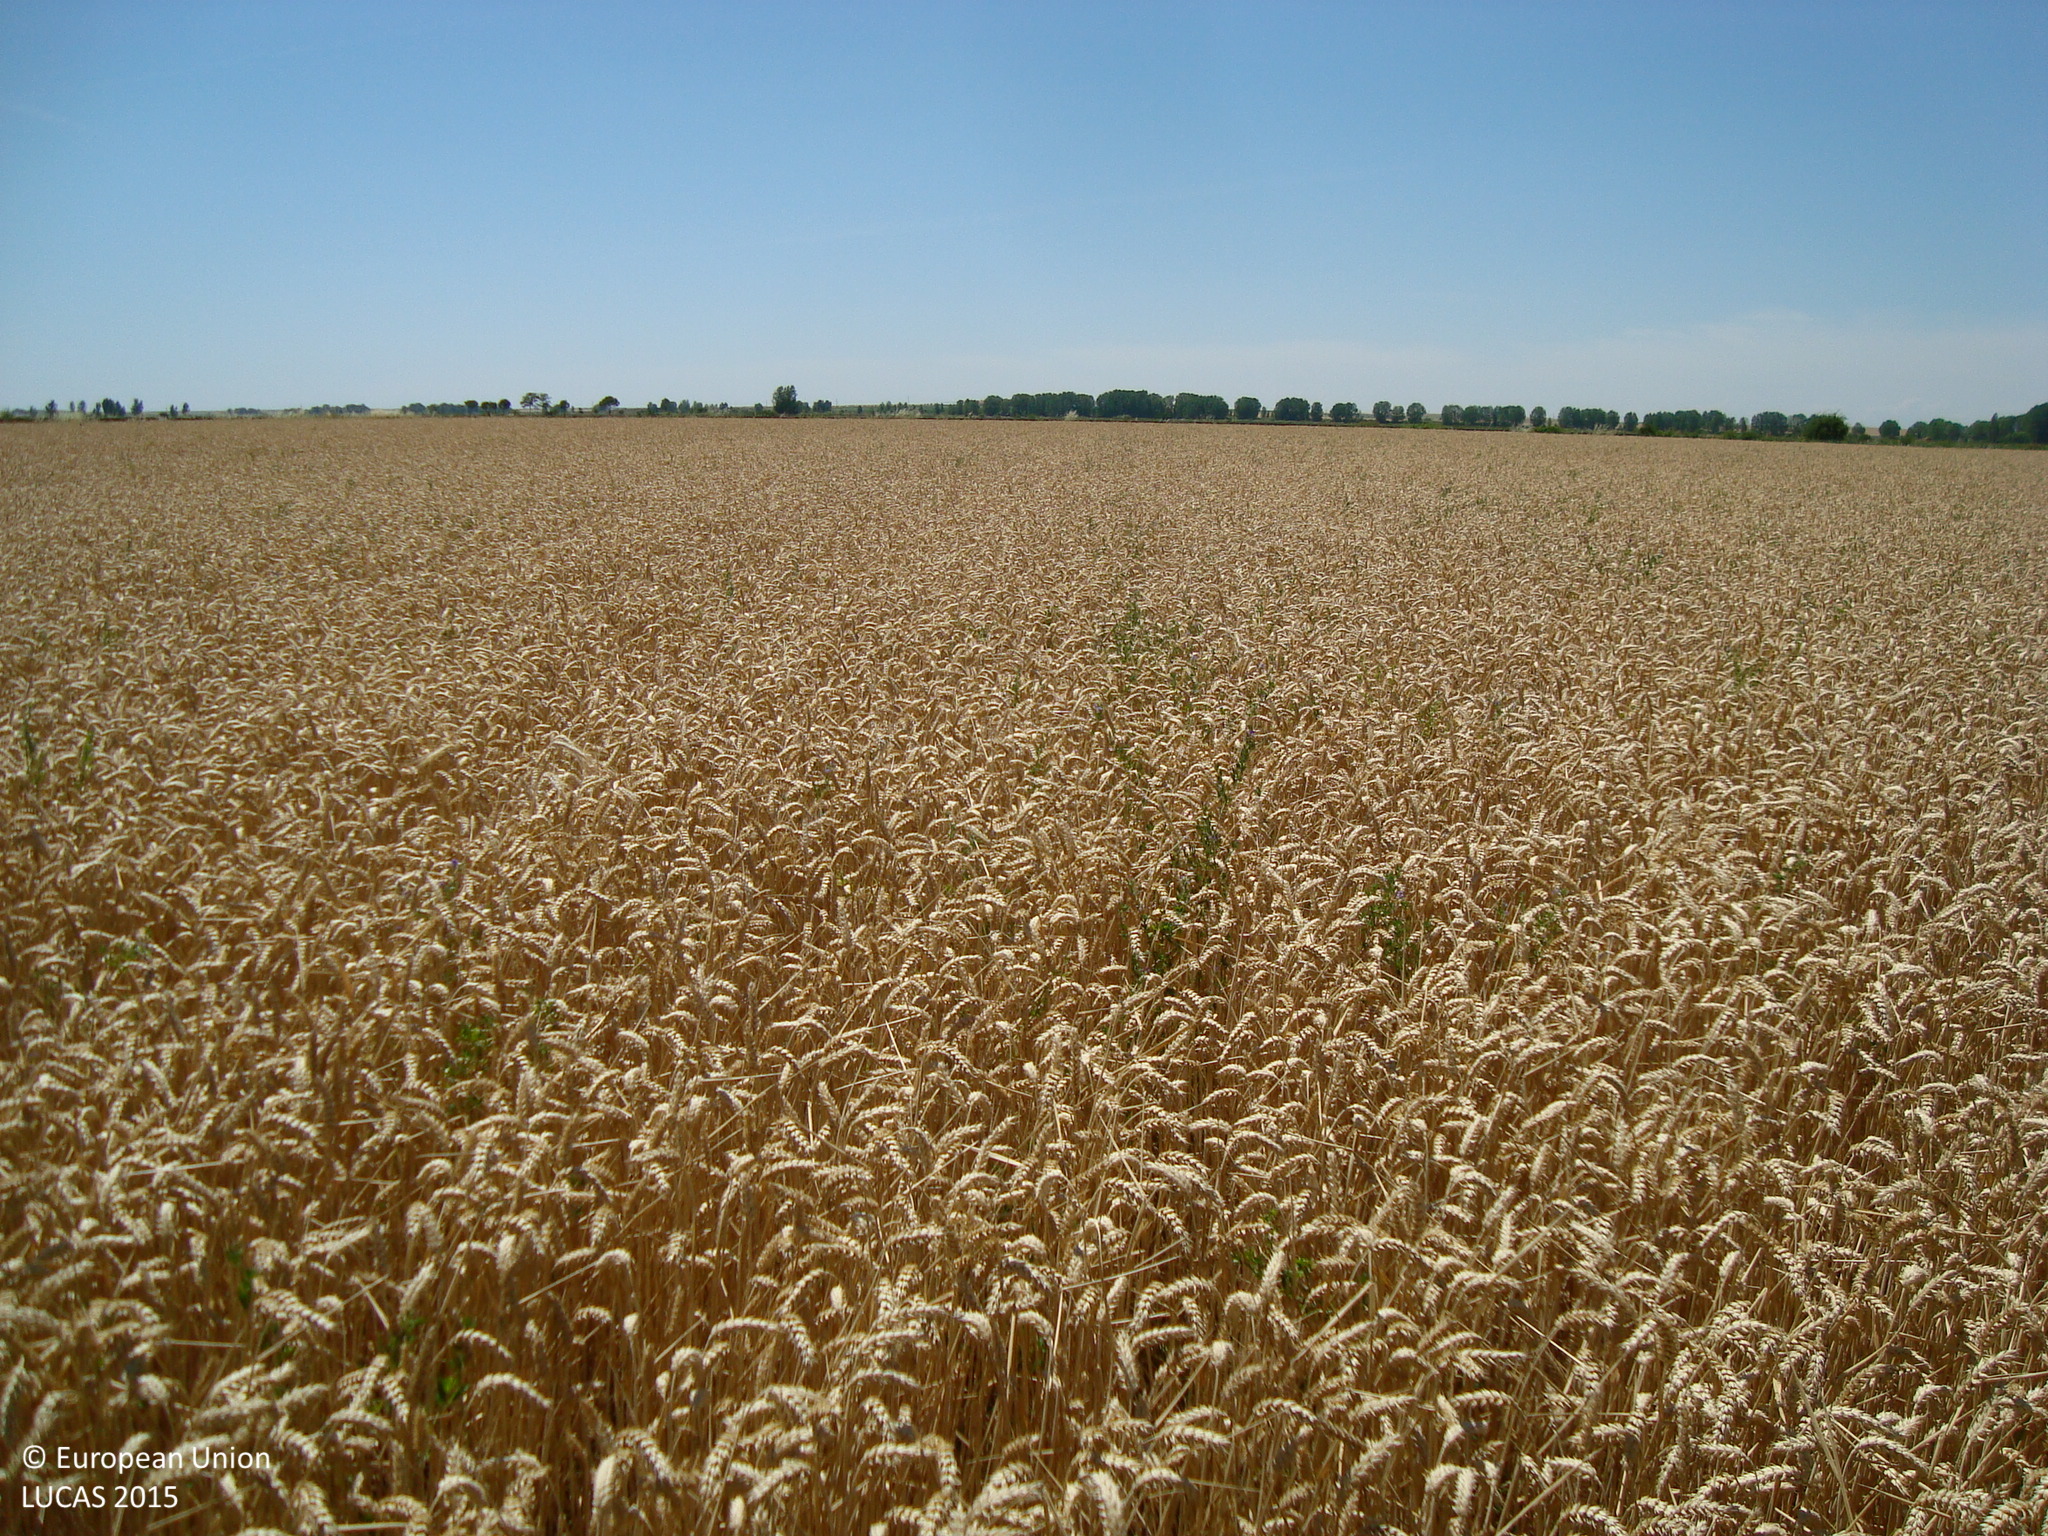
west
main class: Cropland
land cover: Common wheat
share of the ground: > 75 %
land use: Agriculture (excluding fallow land and kitchen gardens)
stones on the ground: < 10 %
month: July
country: ES
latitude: 42.1566
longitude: -4.7316
